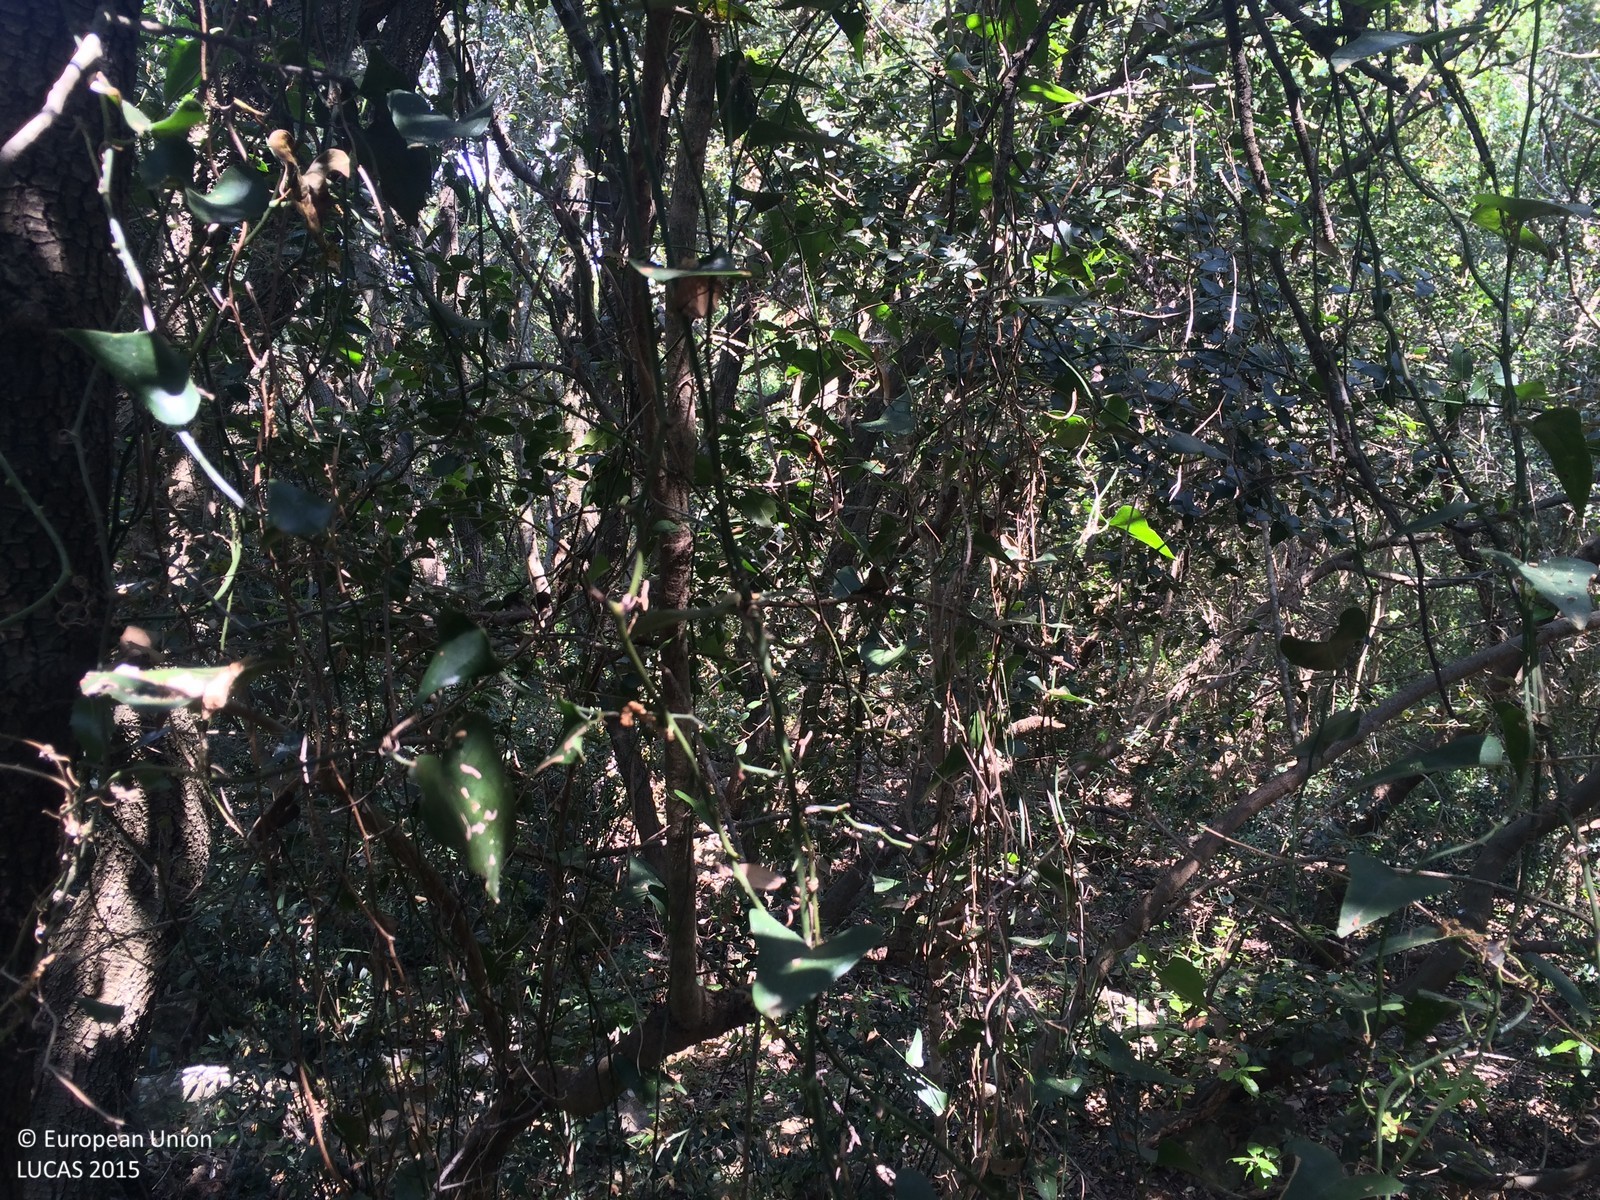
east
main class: Woodland
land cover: Broadleaved woodland
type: broadleaved evergreen forest
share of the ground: > 75 %
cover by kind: broadleaved forest trees 90 %, coniferous forest trees 5 %, shrubs 5 %
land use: Semi-natural and natural areas not in use
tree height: > 5 m
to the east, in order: Broadleaved woodland; Other bare soil; Broadleaved woodland
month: June
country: HR
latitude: 44.8387
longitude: 13.8524
